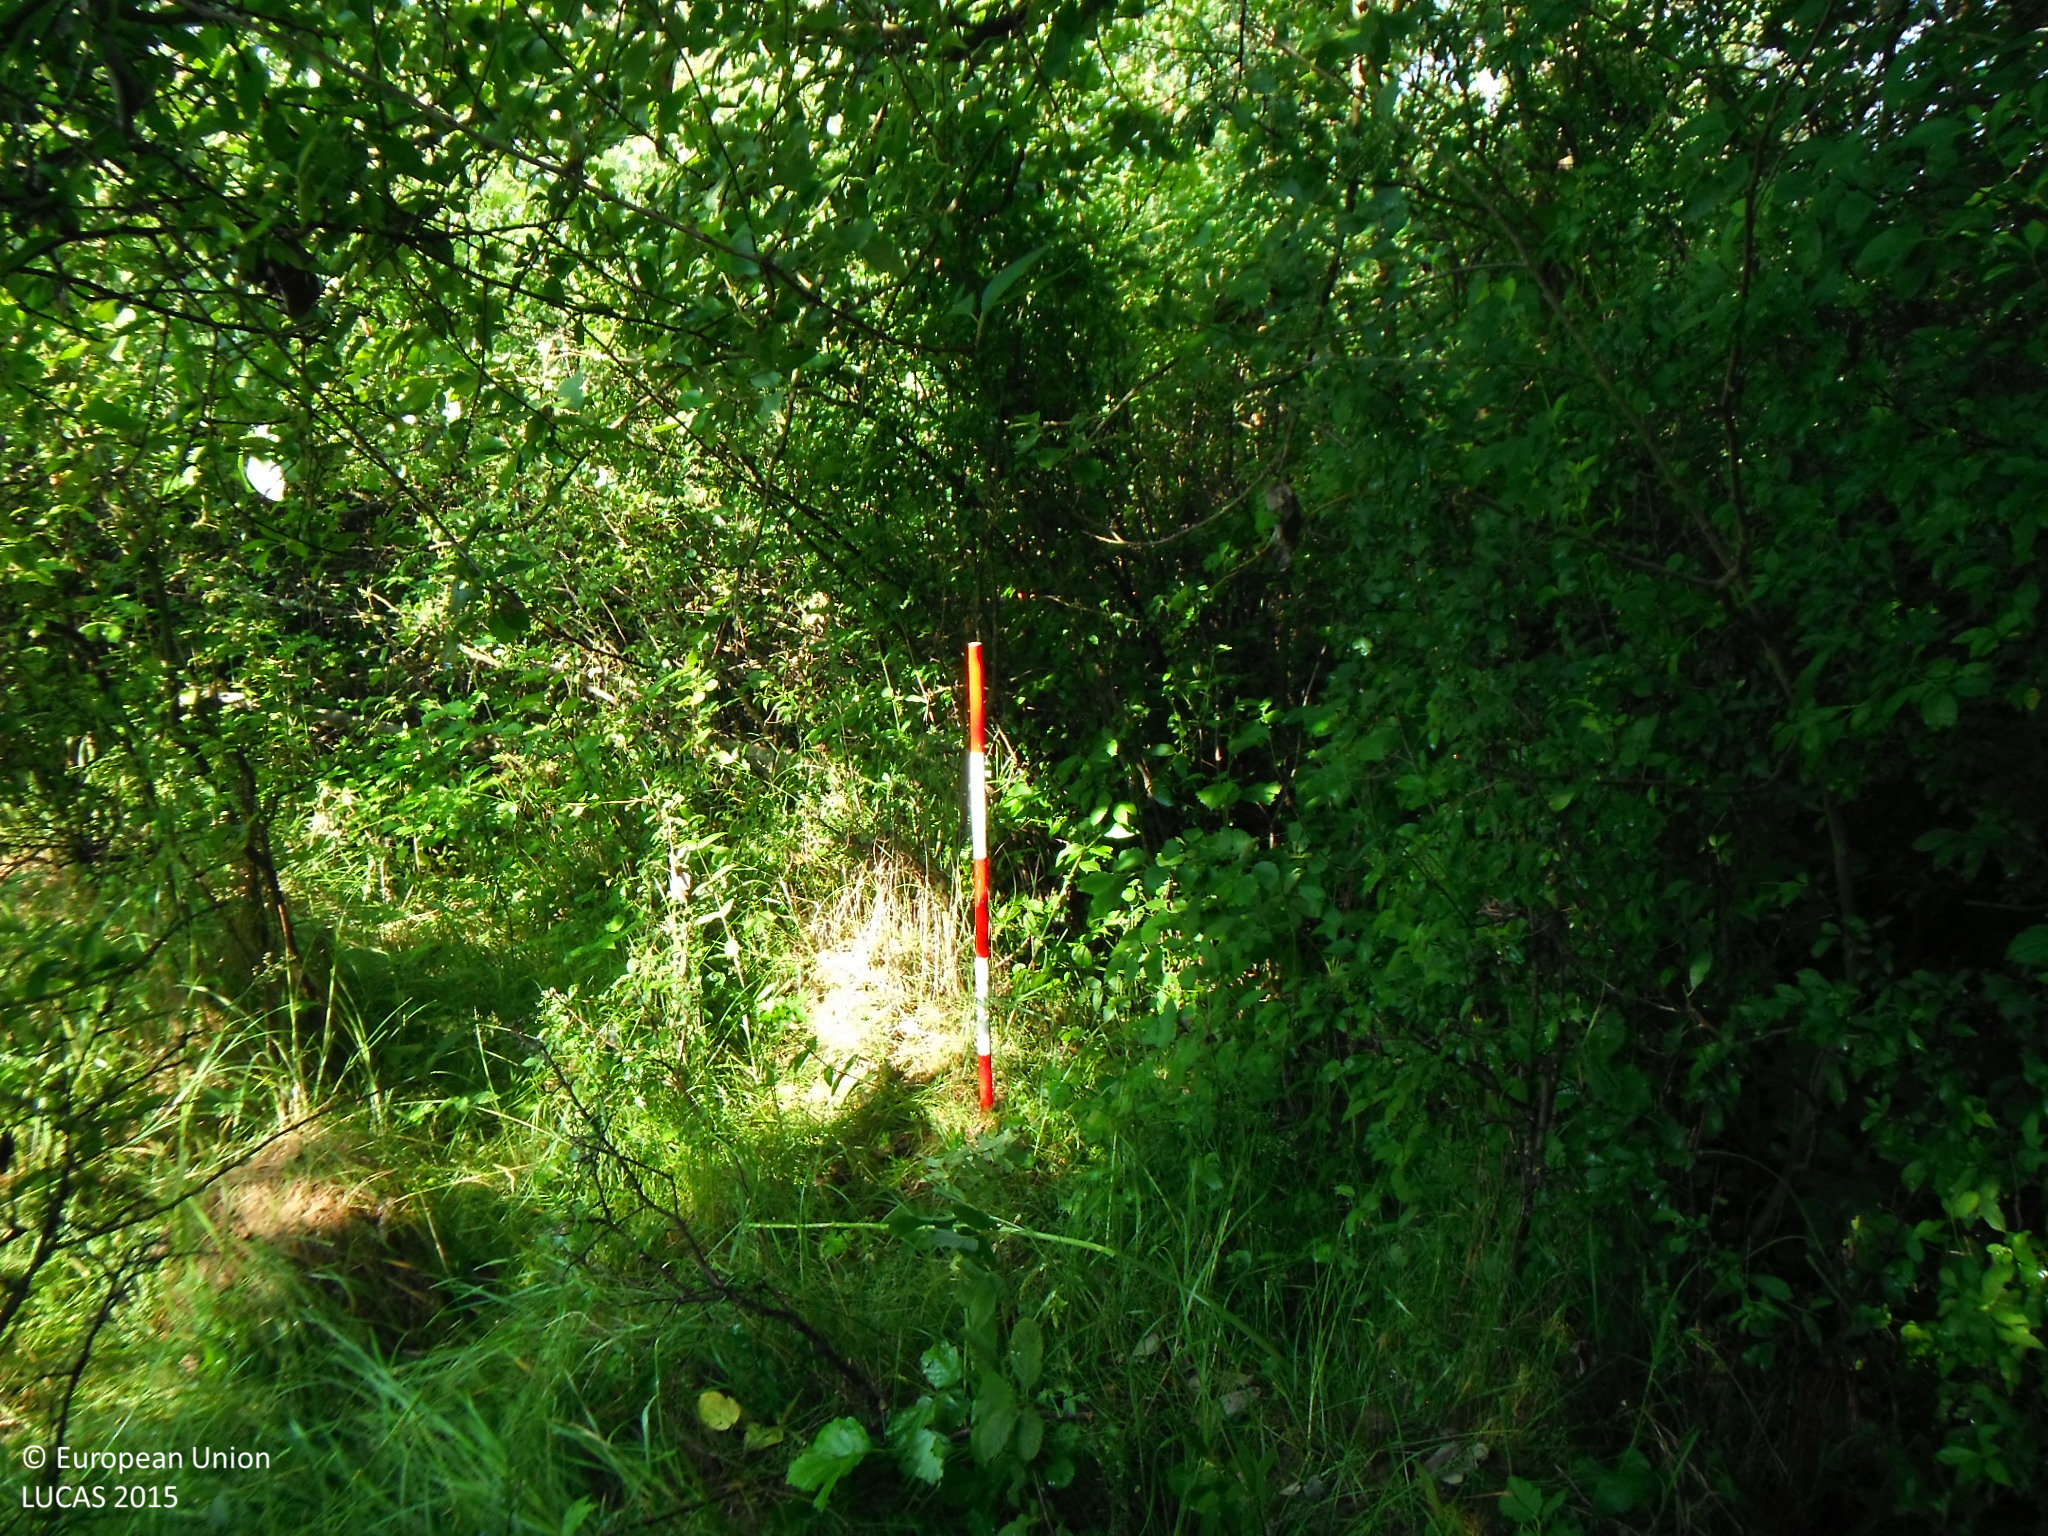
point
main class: Woodland
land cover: Pine dominated mixed woodland
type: hemiboreal forest and nemoral coniferous forest and mixed broadleaved-coniferous forest
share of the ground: > 75 %
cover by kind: coniferous forest trees 50 %, broadleaved forest trees 45 %, shrubs 5 %
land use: Forestry
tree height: > 5 m
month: July
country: SK
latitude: 49.2013
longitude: 21.3141
